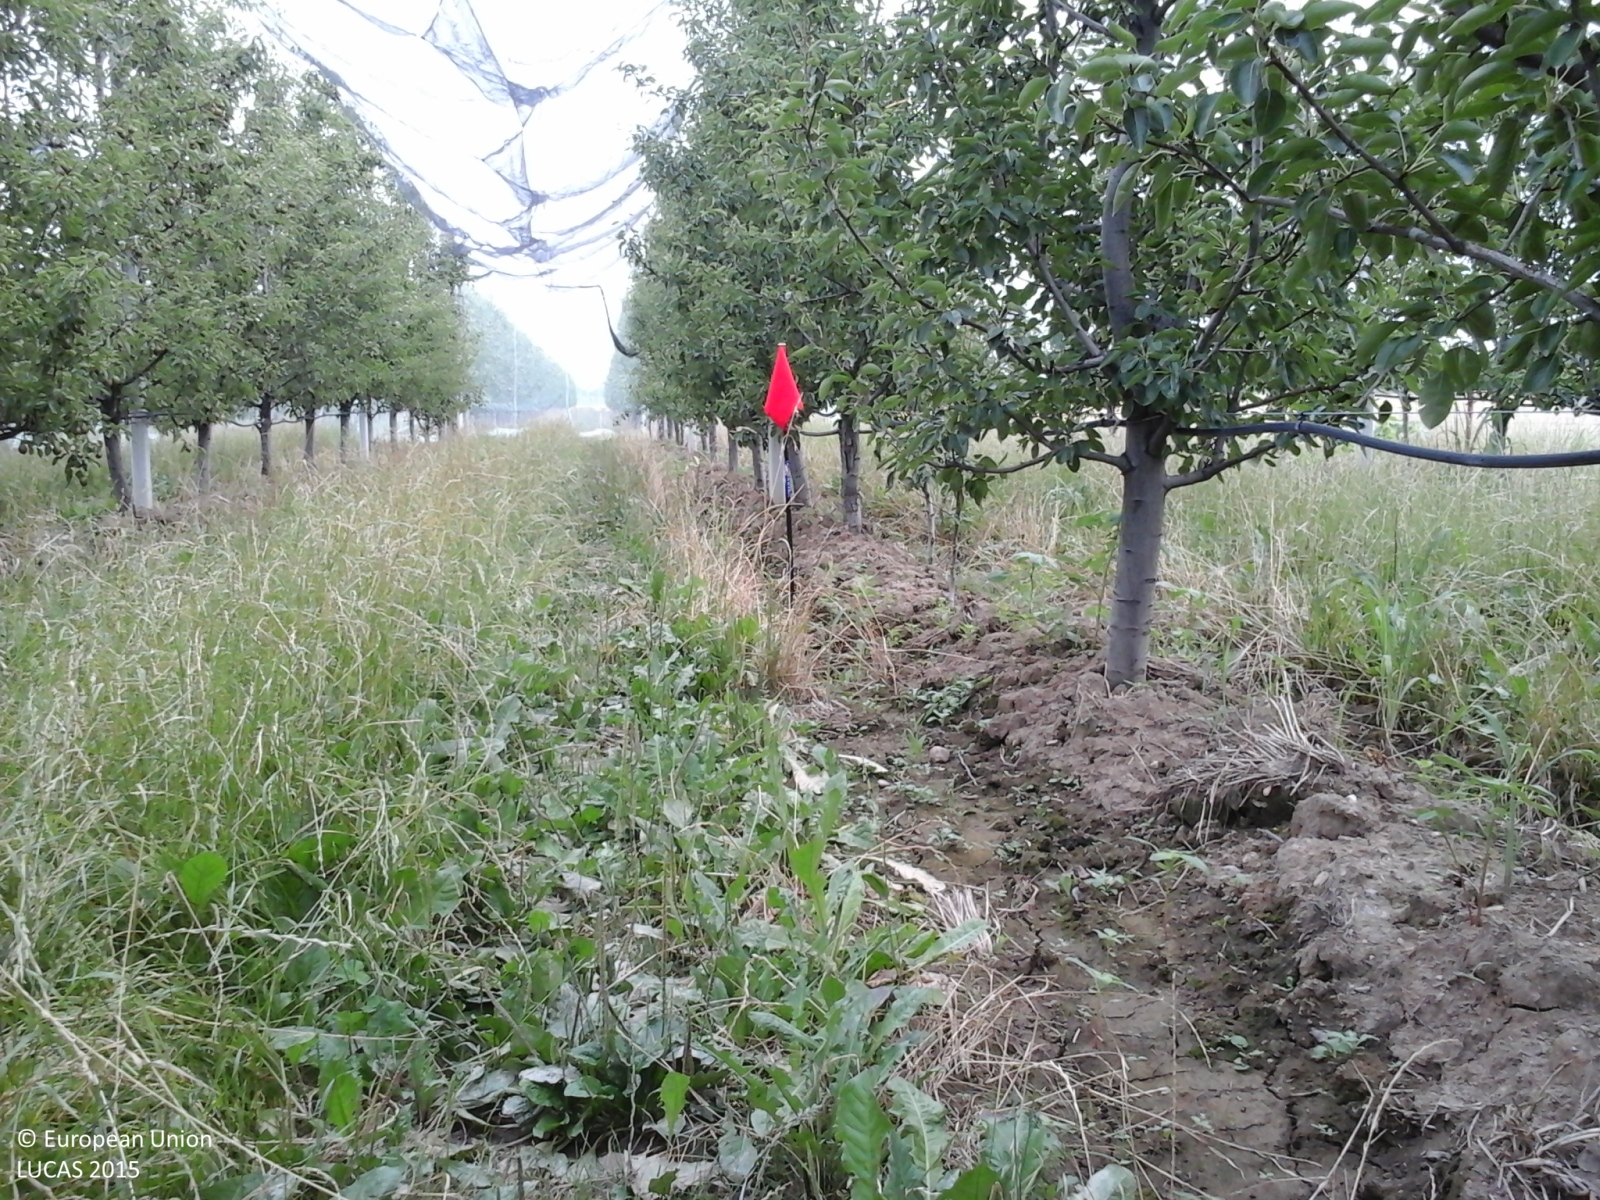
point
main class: Cropland
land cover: Pear fruit
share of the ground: 50 - 75 %
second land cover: Grassland without tree/shrub cover
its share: > 75 %
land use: Agriculture (excluding fallow land and kitchen gardens)
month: July
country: IT
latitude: 44.5736
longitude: 7.5242
